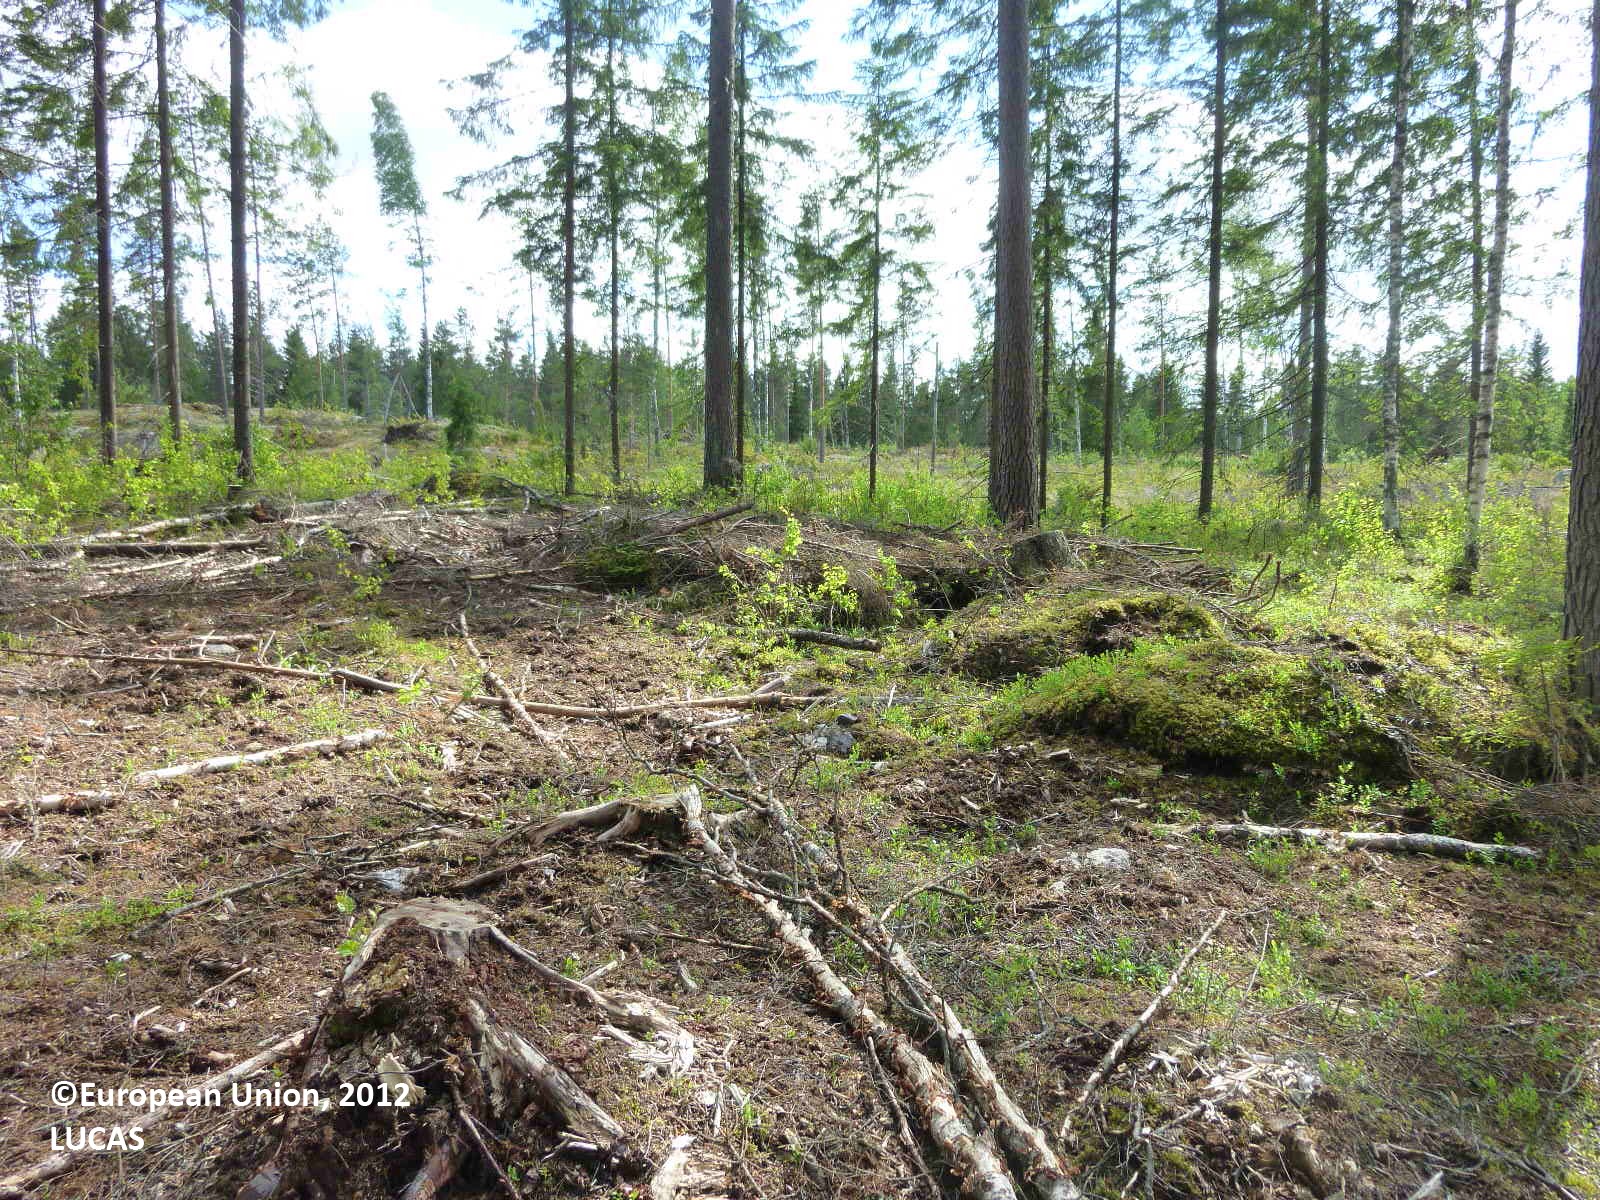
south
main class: Woodland
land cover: Spruce dominated mixed woodland
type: boreal forest
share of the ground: 50 - 75 %
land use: Forestry
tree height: > 5 m
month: June
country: FI
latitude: 61.7395
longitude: 22.3082
